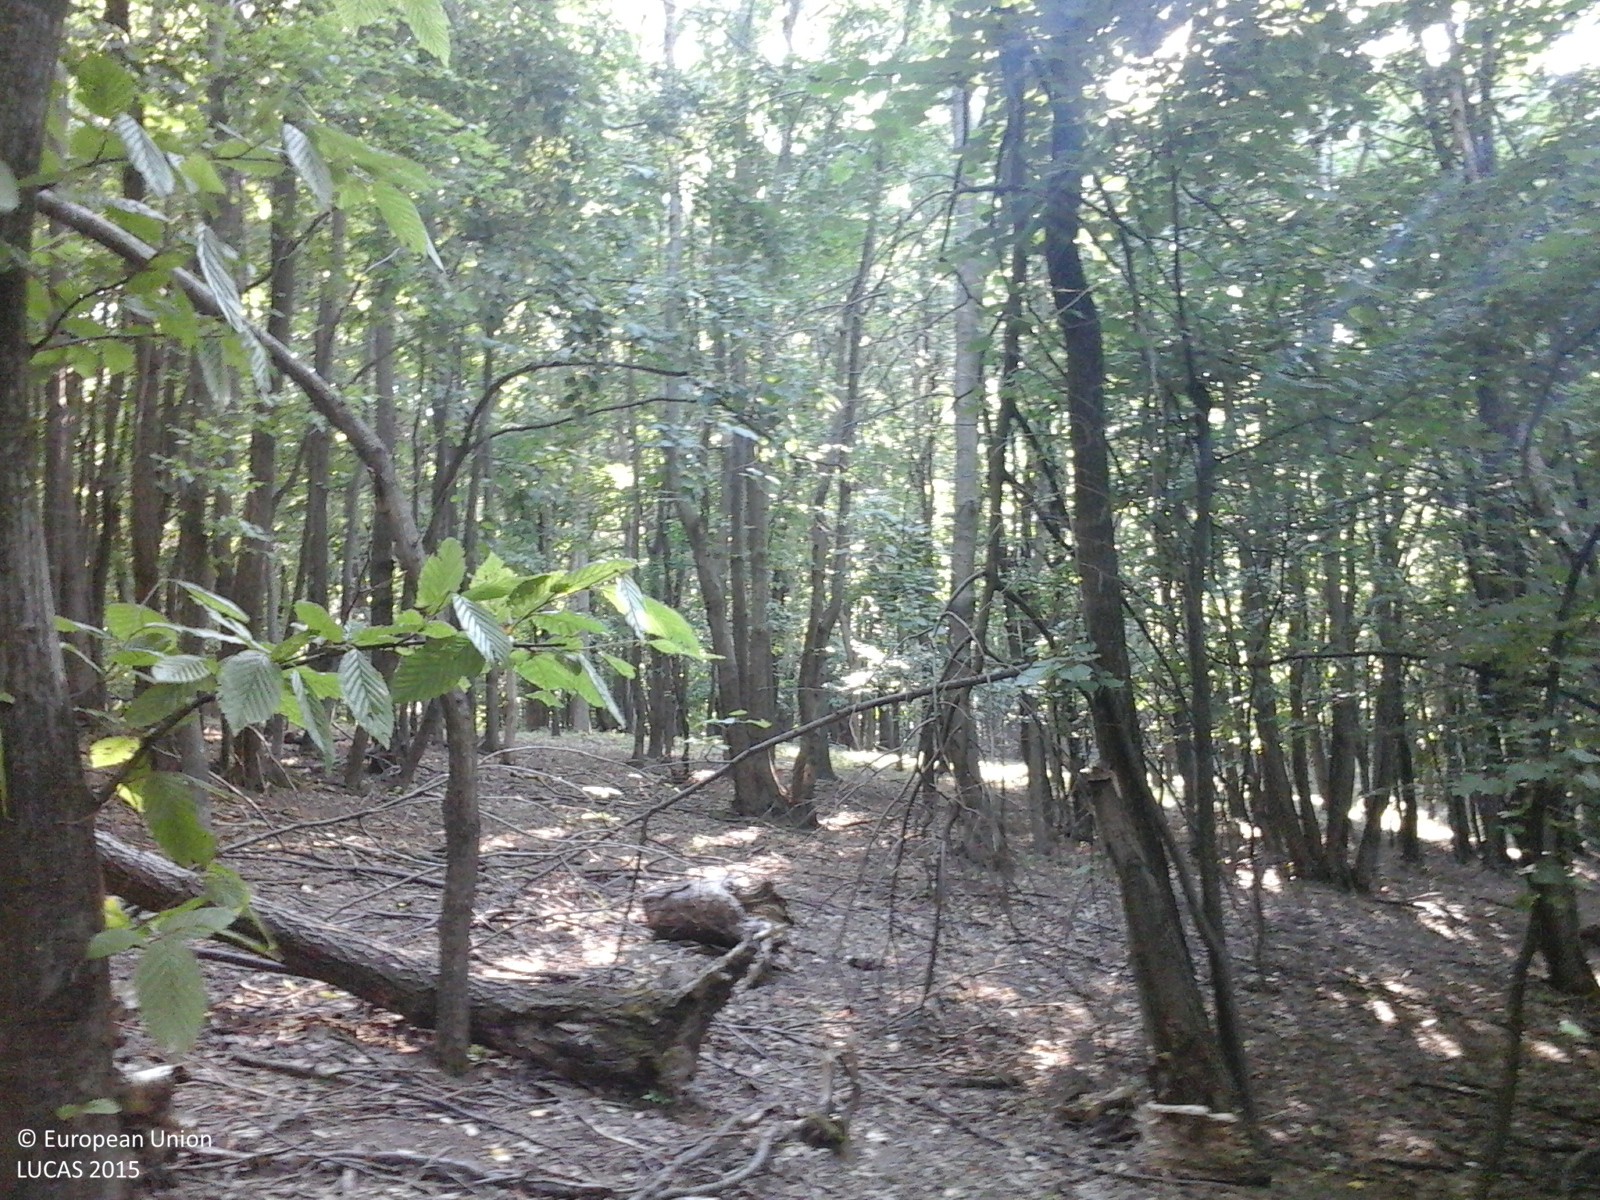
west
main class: Woodland
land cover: Broadleaved woodland
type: mesophytic deciduous forest
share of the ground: > 75 %
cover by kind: broadleaved forest trees 100 %
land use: Forestry
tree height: > 5 m
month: June
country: RO
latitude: 46.9445
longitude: 27.9020
